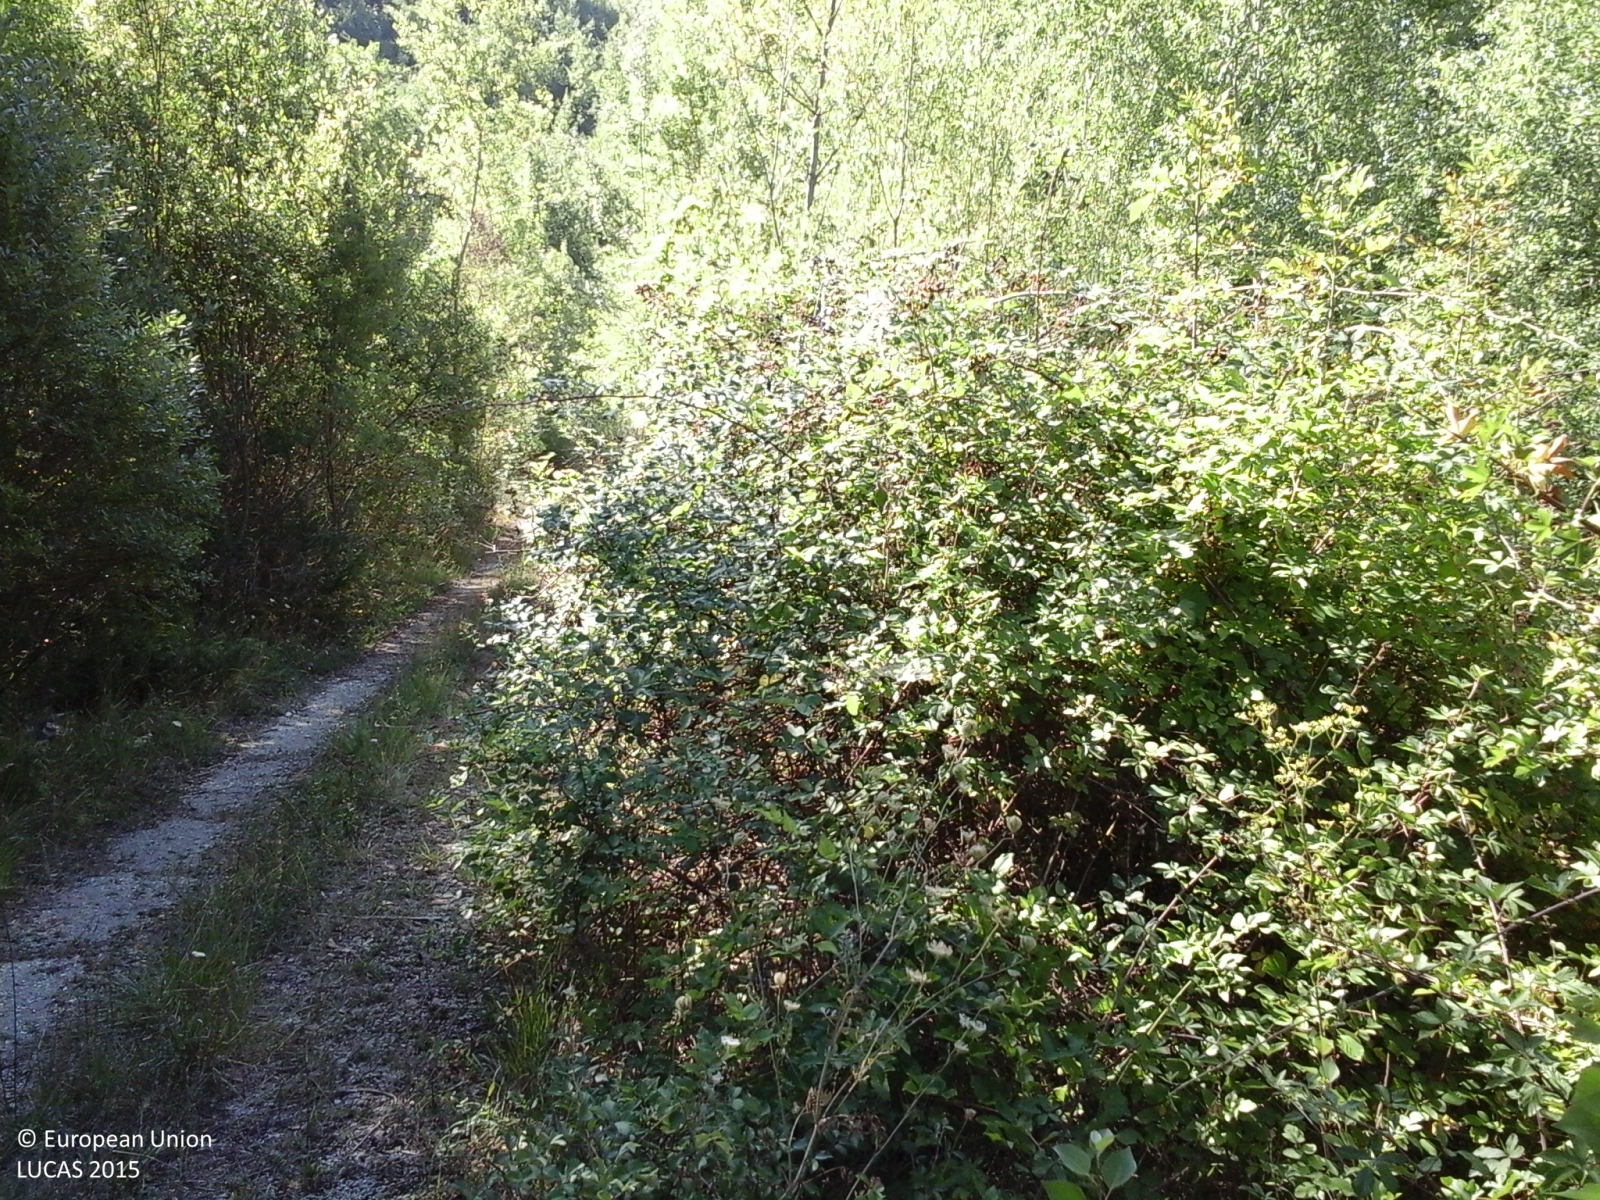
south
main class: Woodland
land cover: Broadleaved woodland
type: thermophilous deciduous forest
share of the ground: > 75 %
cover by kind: broadleaved forest trees 90 %, shrubs 5 %, herbaceous plants 5 %
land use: Semi-natural and natural areas not in use
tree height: > 5 m
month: September
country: IT
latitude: 41.6795
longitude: 14.2256
